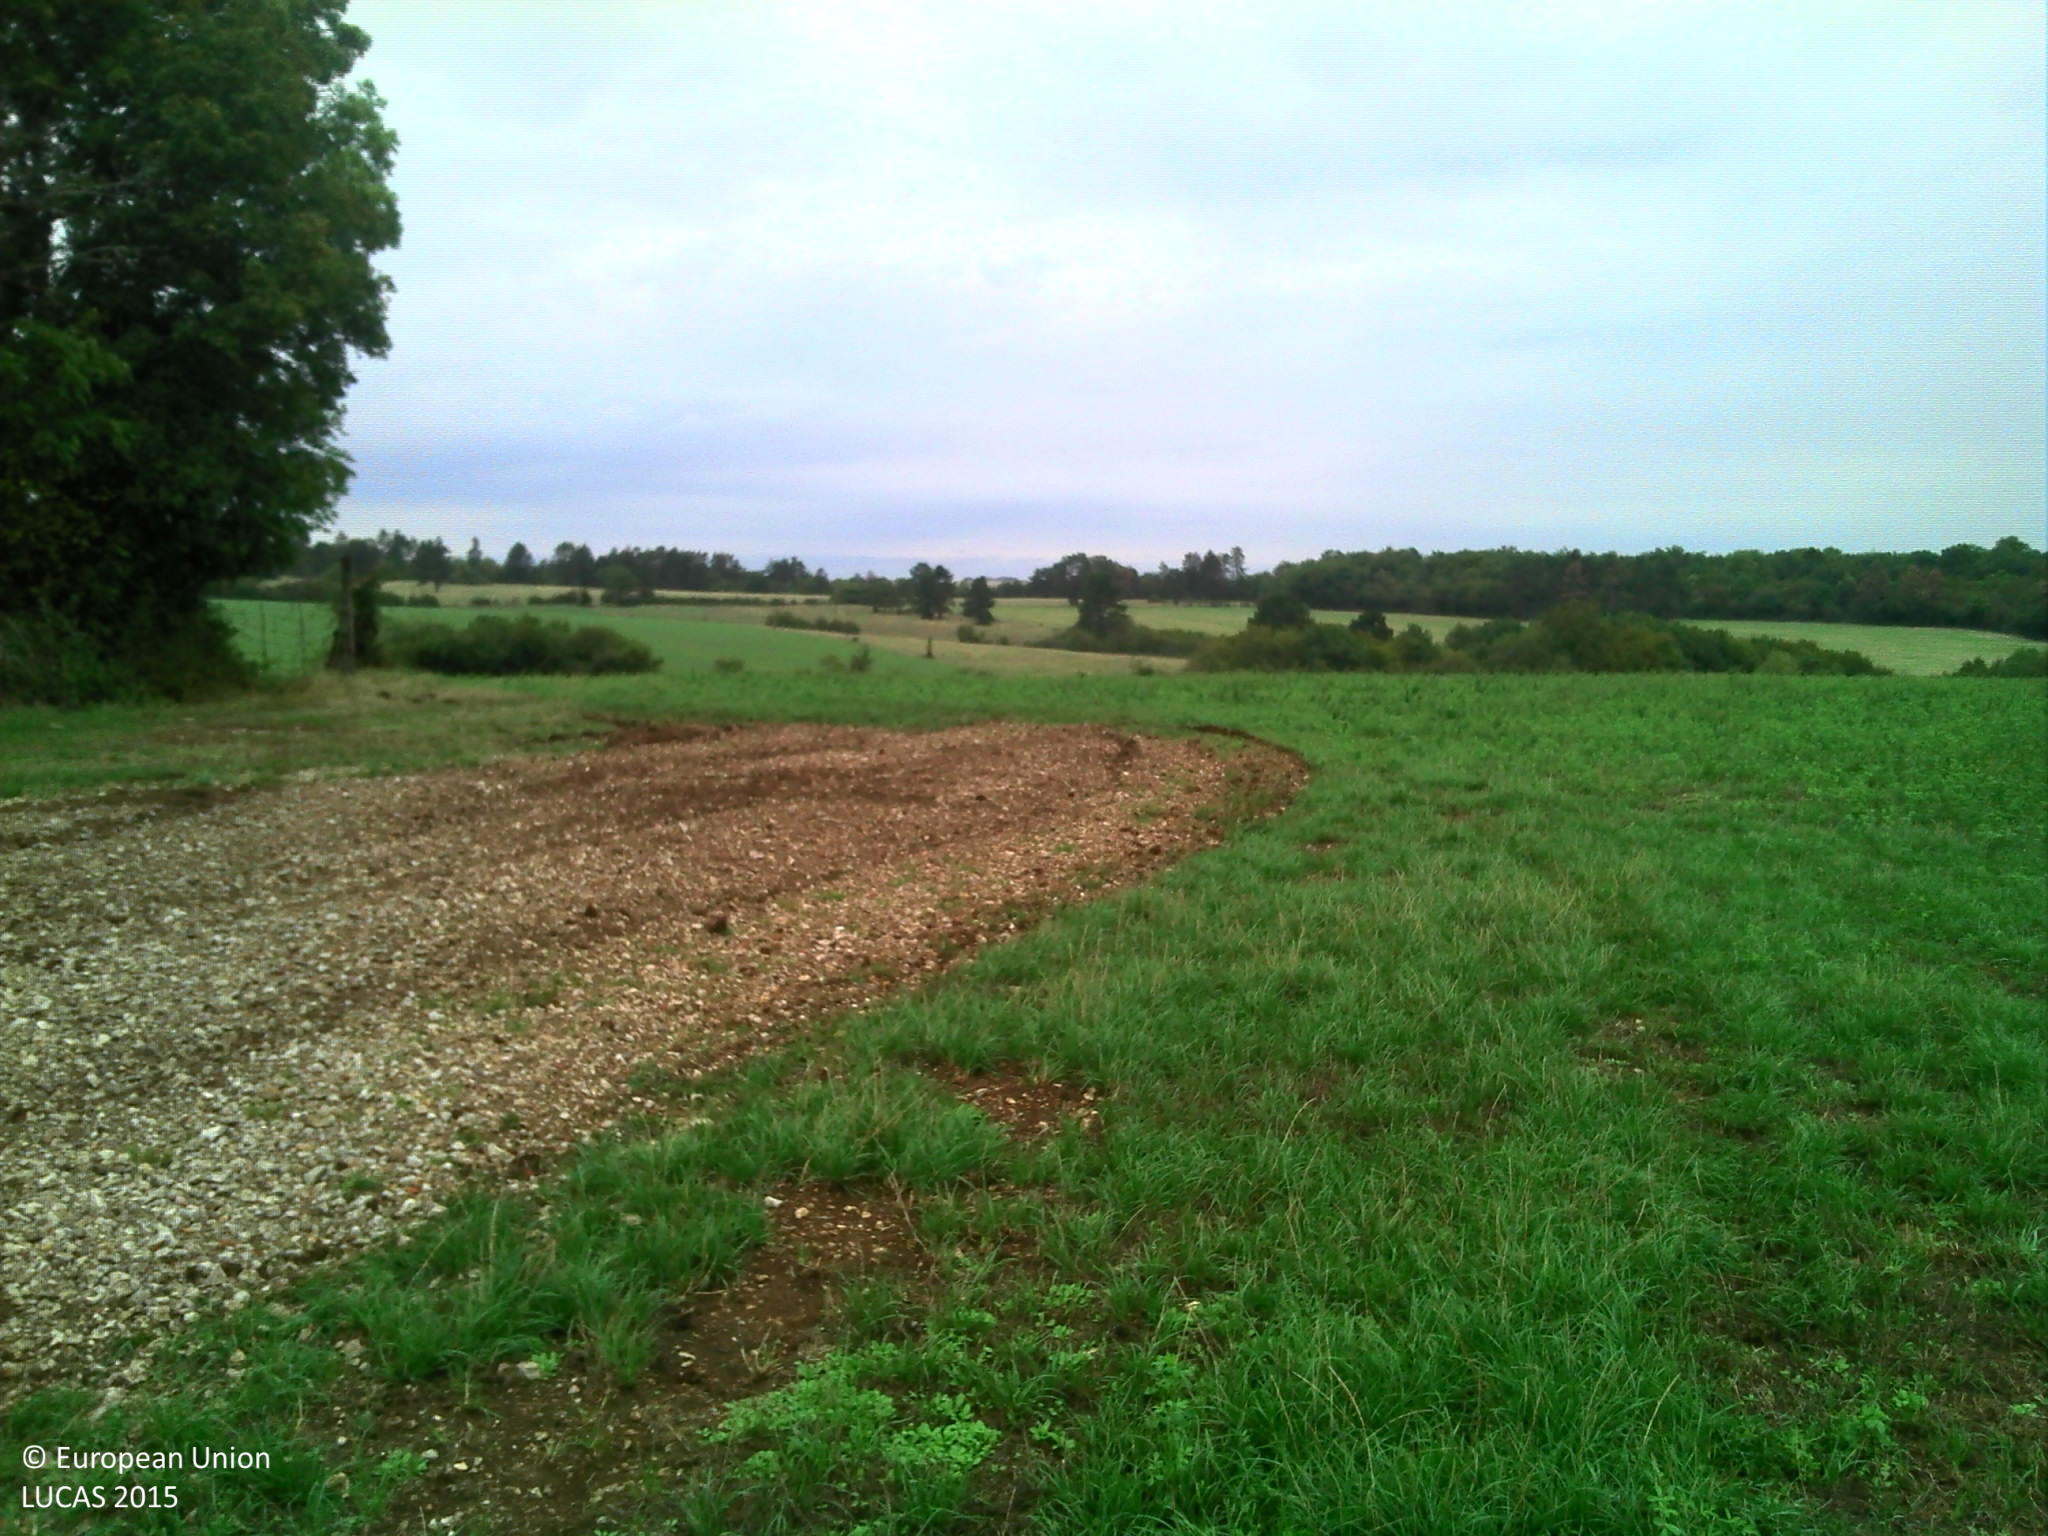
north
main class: Cropland
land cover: Lucerne
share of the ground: 25 - 50 %
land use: Agriculture (excluding fallow land and kitchen gardens)
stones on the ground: < 10 %
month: August
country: FR
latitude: 47.3984
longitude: 4.8193
